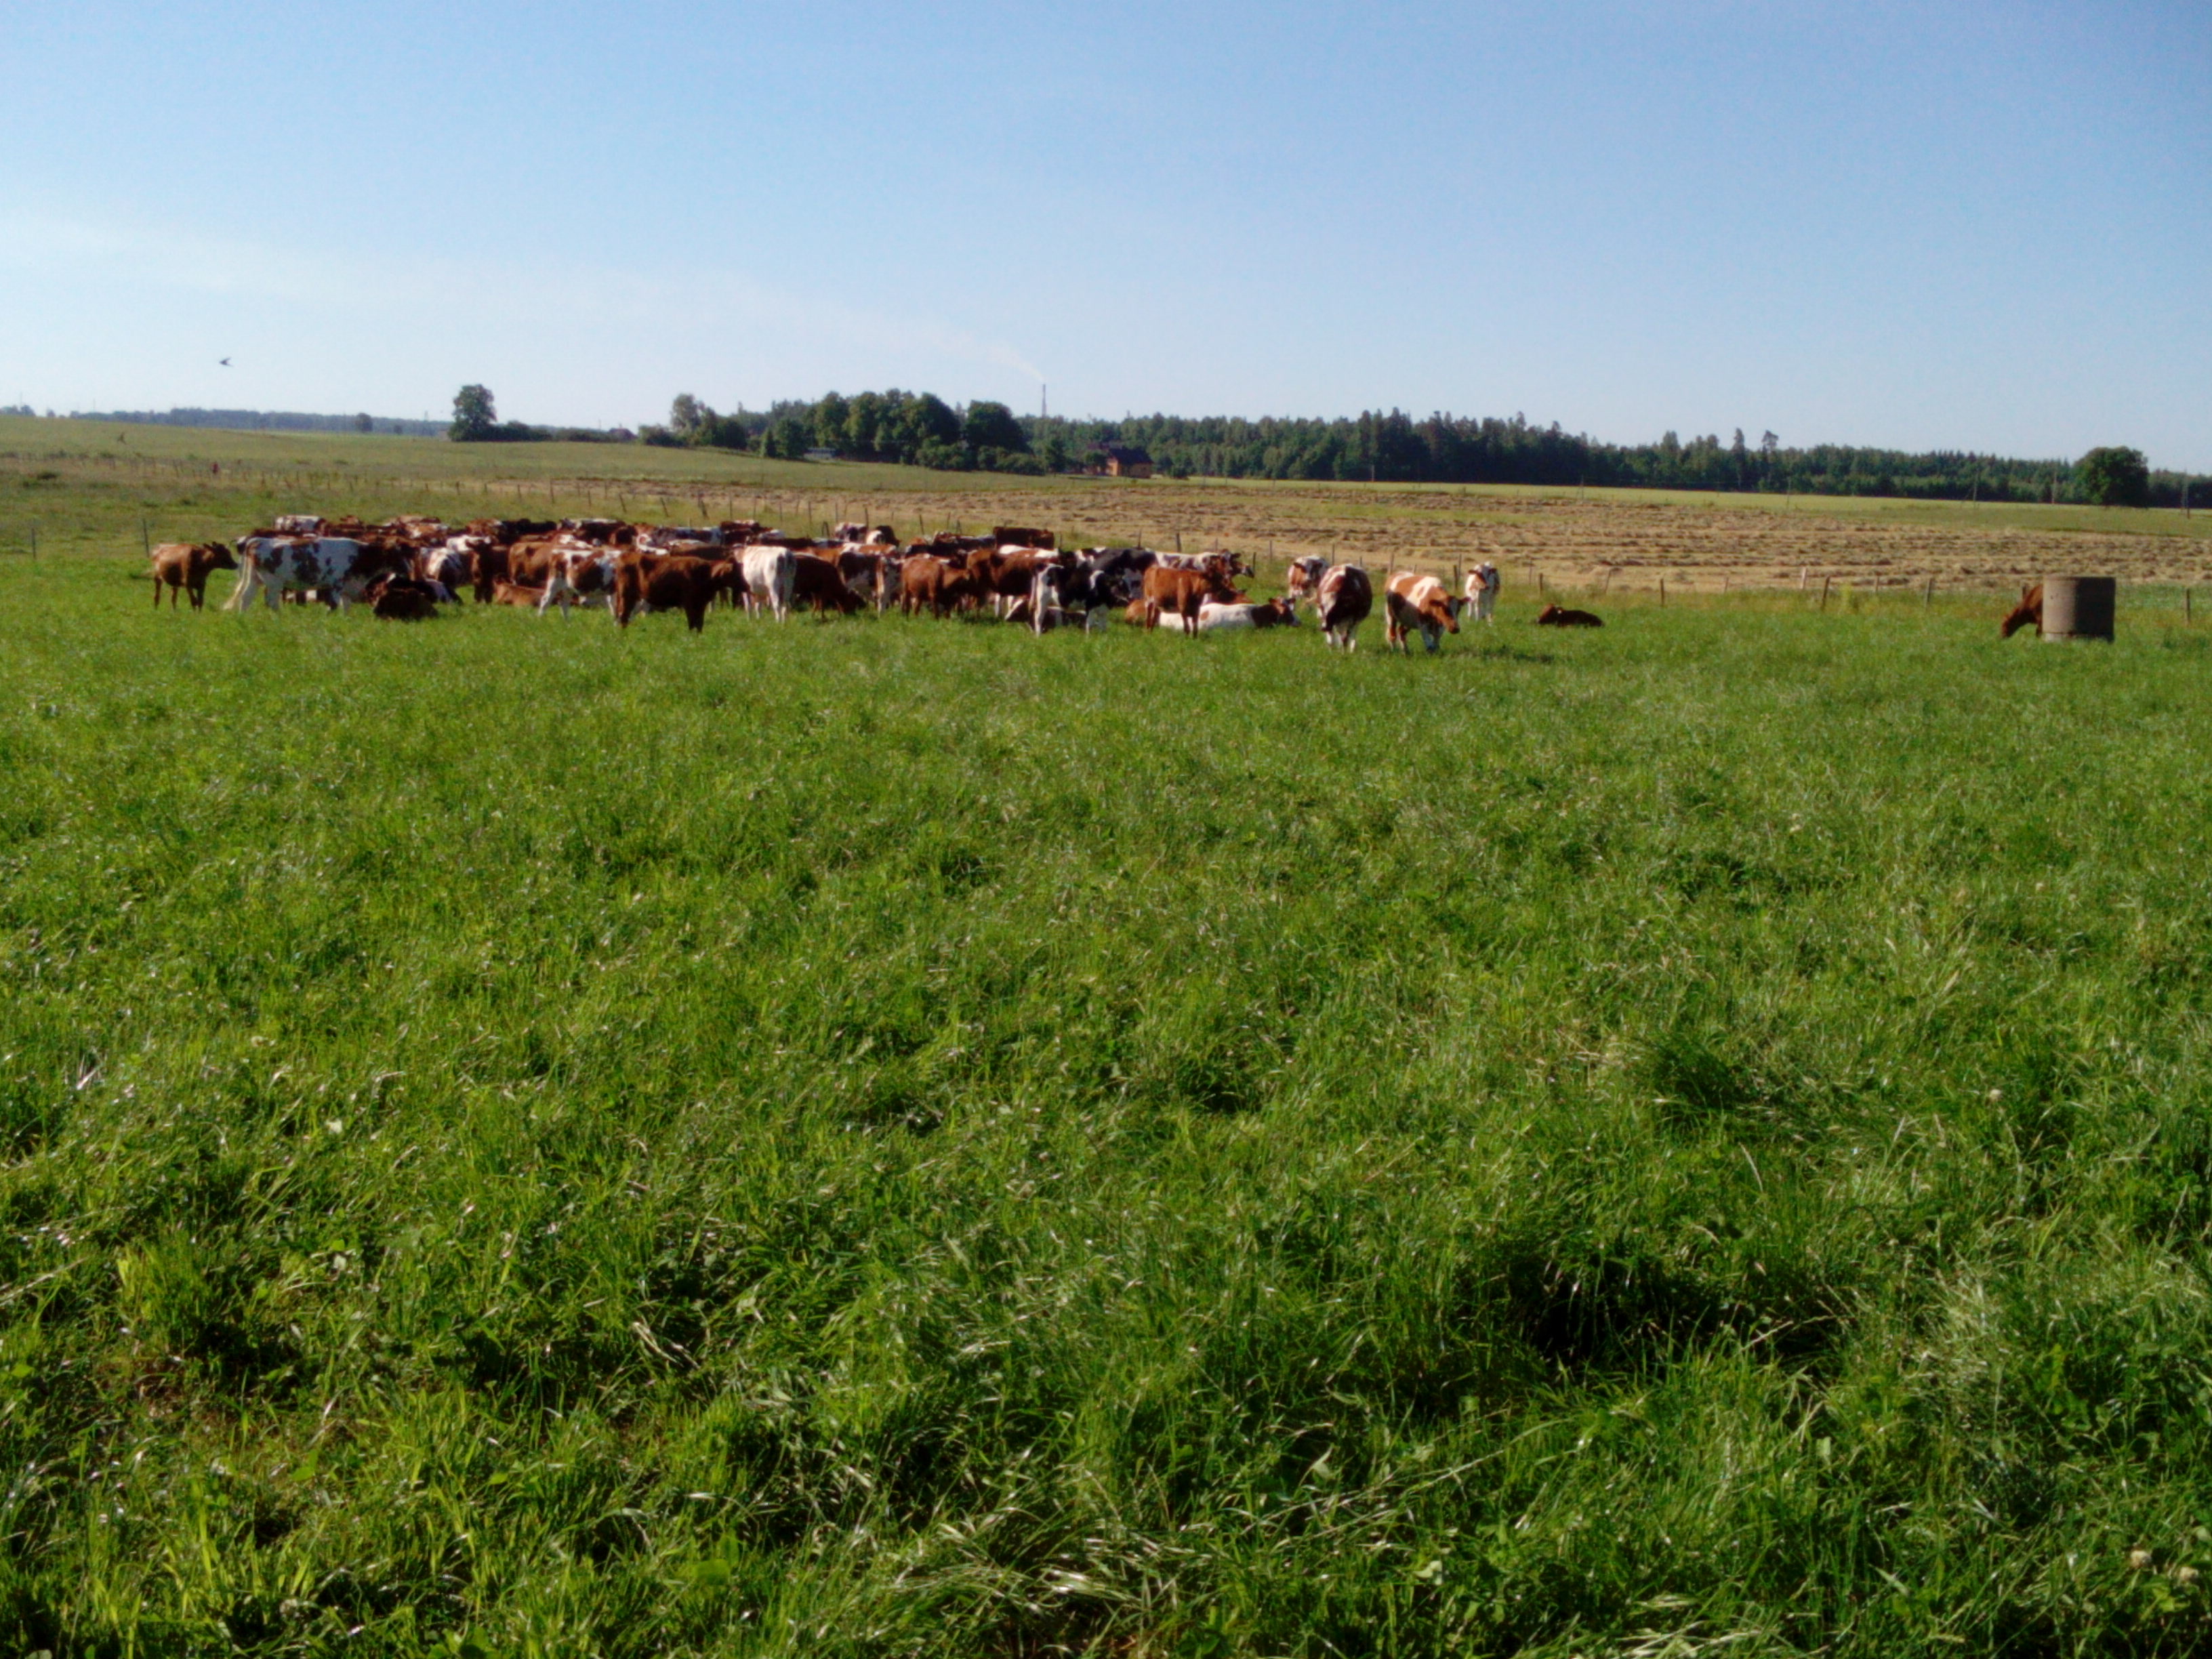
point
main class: Grassland
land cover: Grassland without tree/shrub cover
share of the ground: > 75 %
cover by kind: herbaceous plants 100 %
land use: Agriculture (excluding fallow land and kitchen gardens)
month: July
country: LV
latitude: 56.4465
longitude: 22.1375
